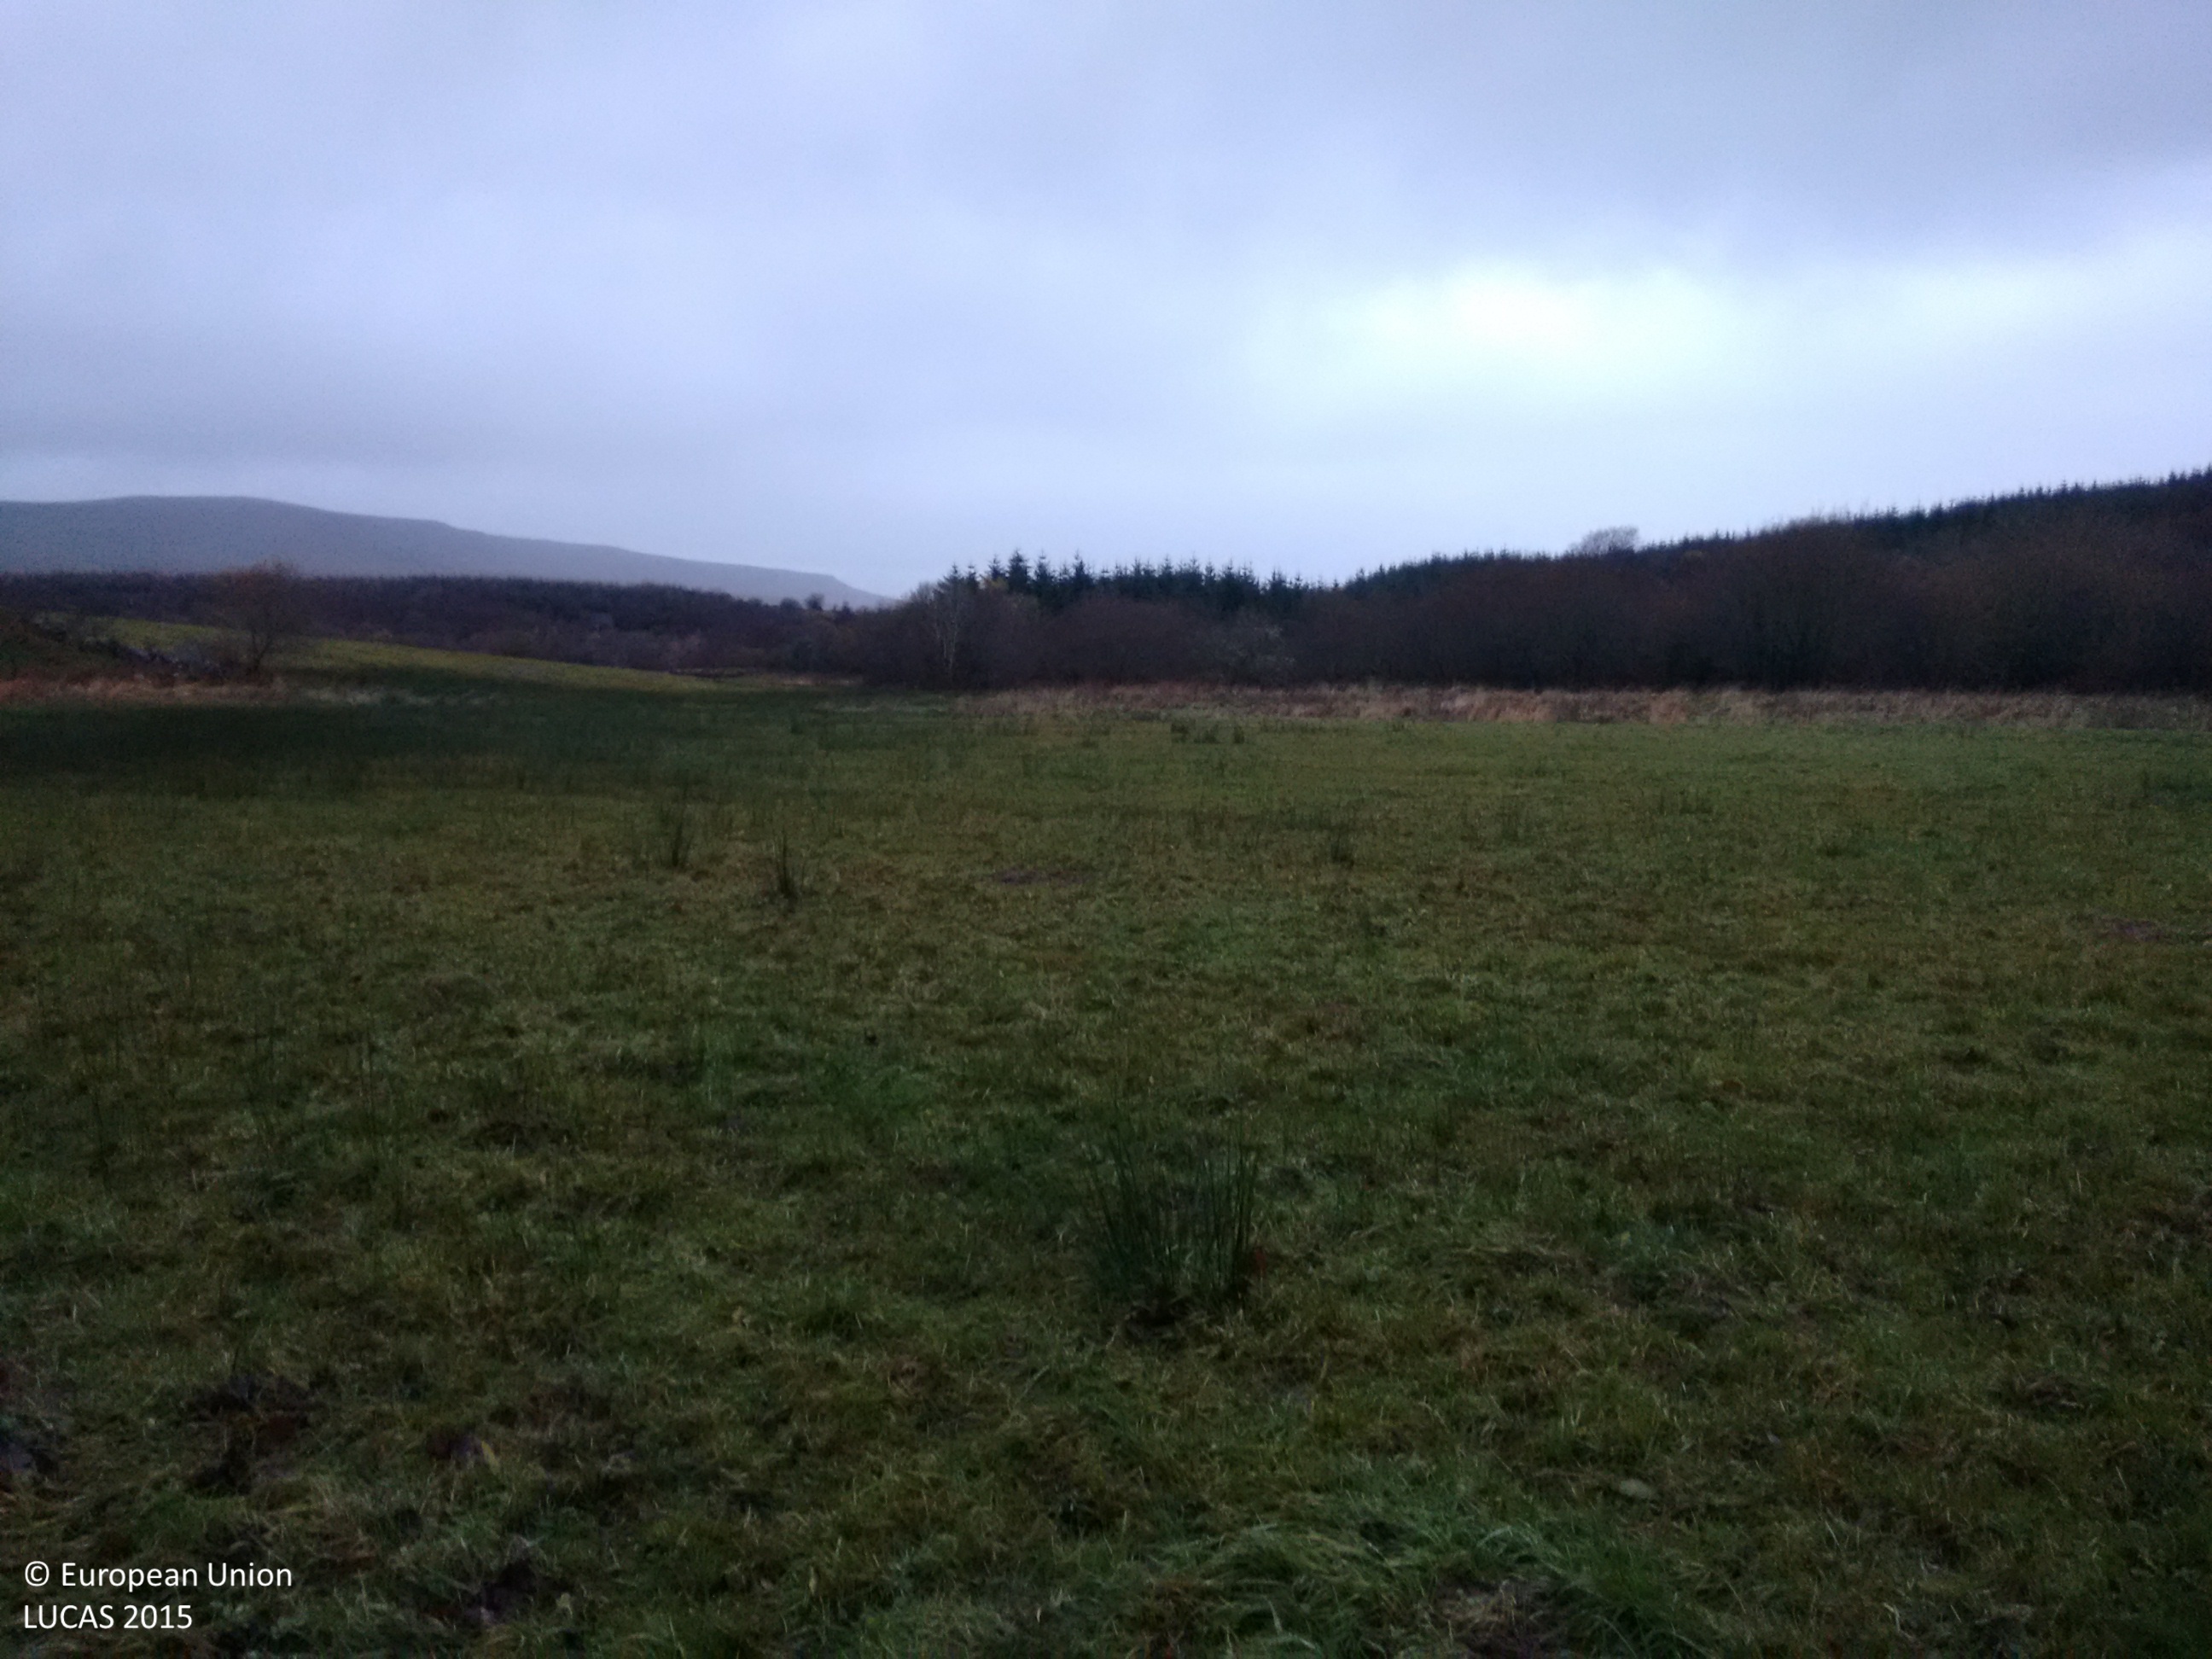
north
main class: Woodland
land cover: Spruce dominated coniferous woodland
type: exotic forest
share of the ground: > 75 %
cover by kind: coniferous forest trees 100 %
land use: Forestry
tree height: > 5 m
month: December
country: IE
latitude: 54.2223
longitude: -7.9480
